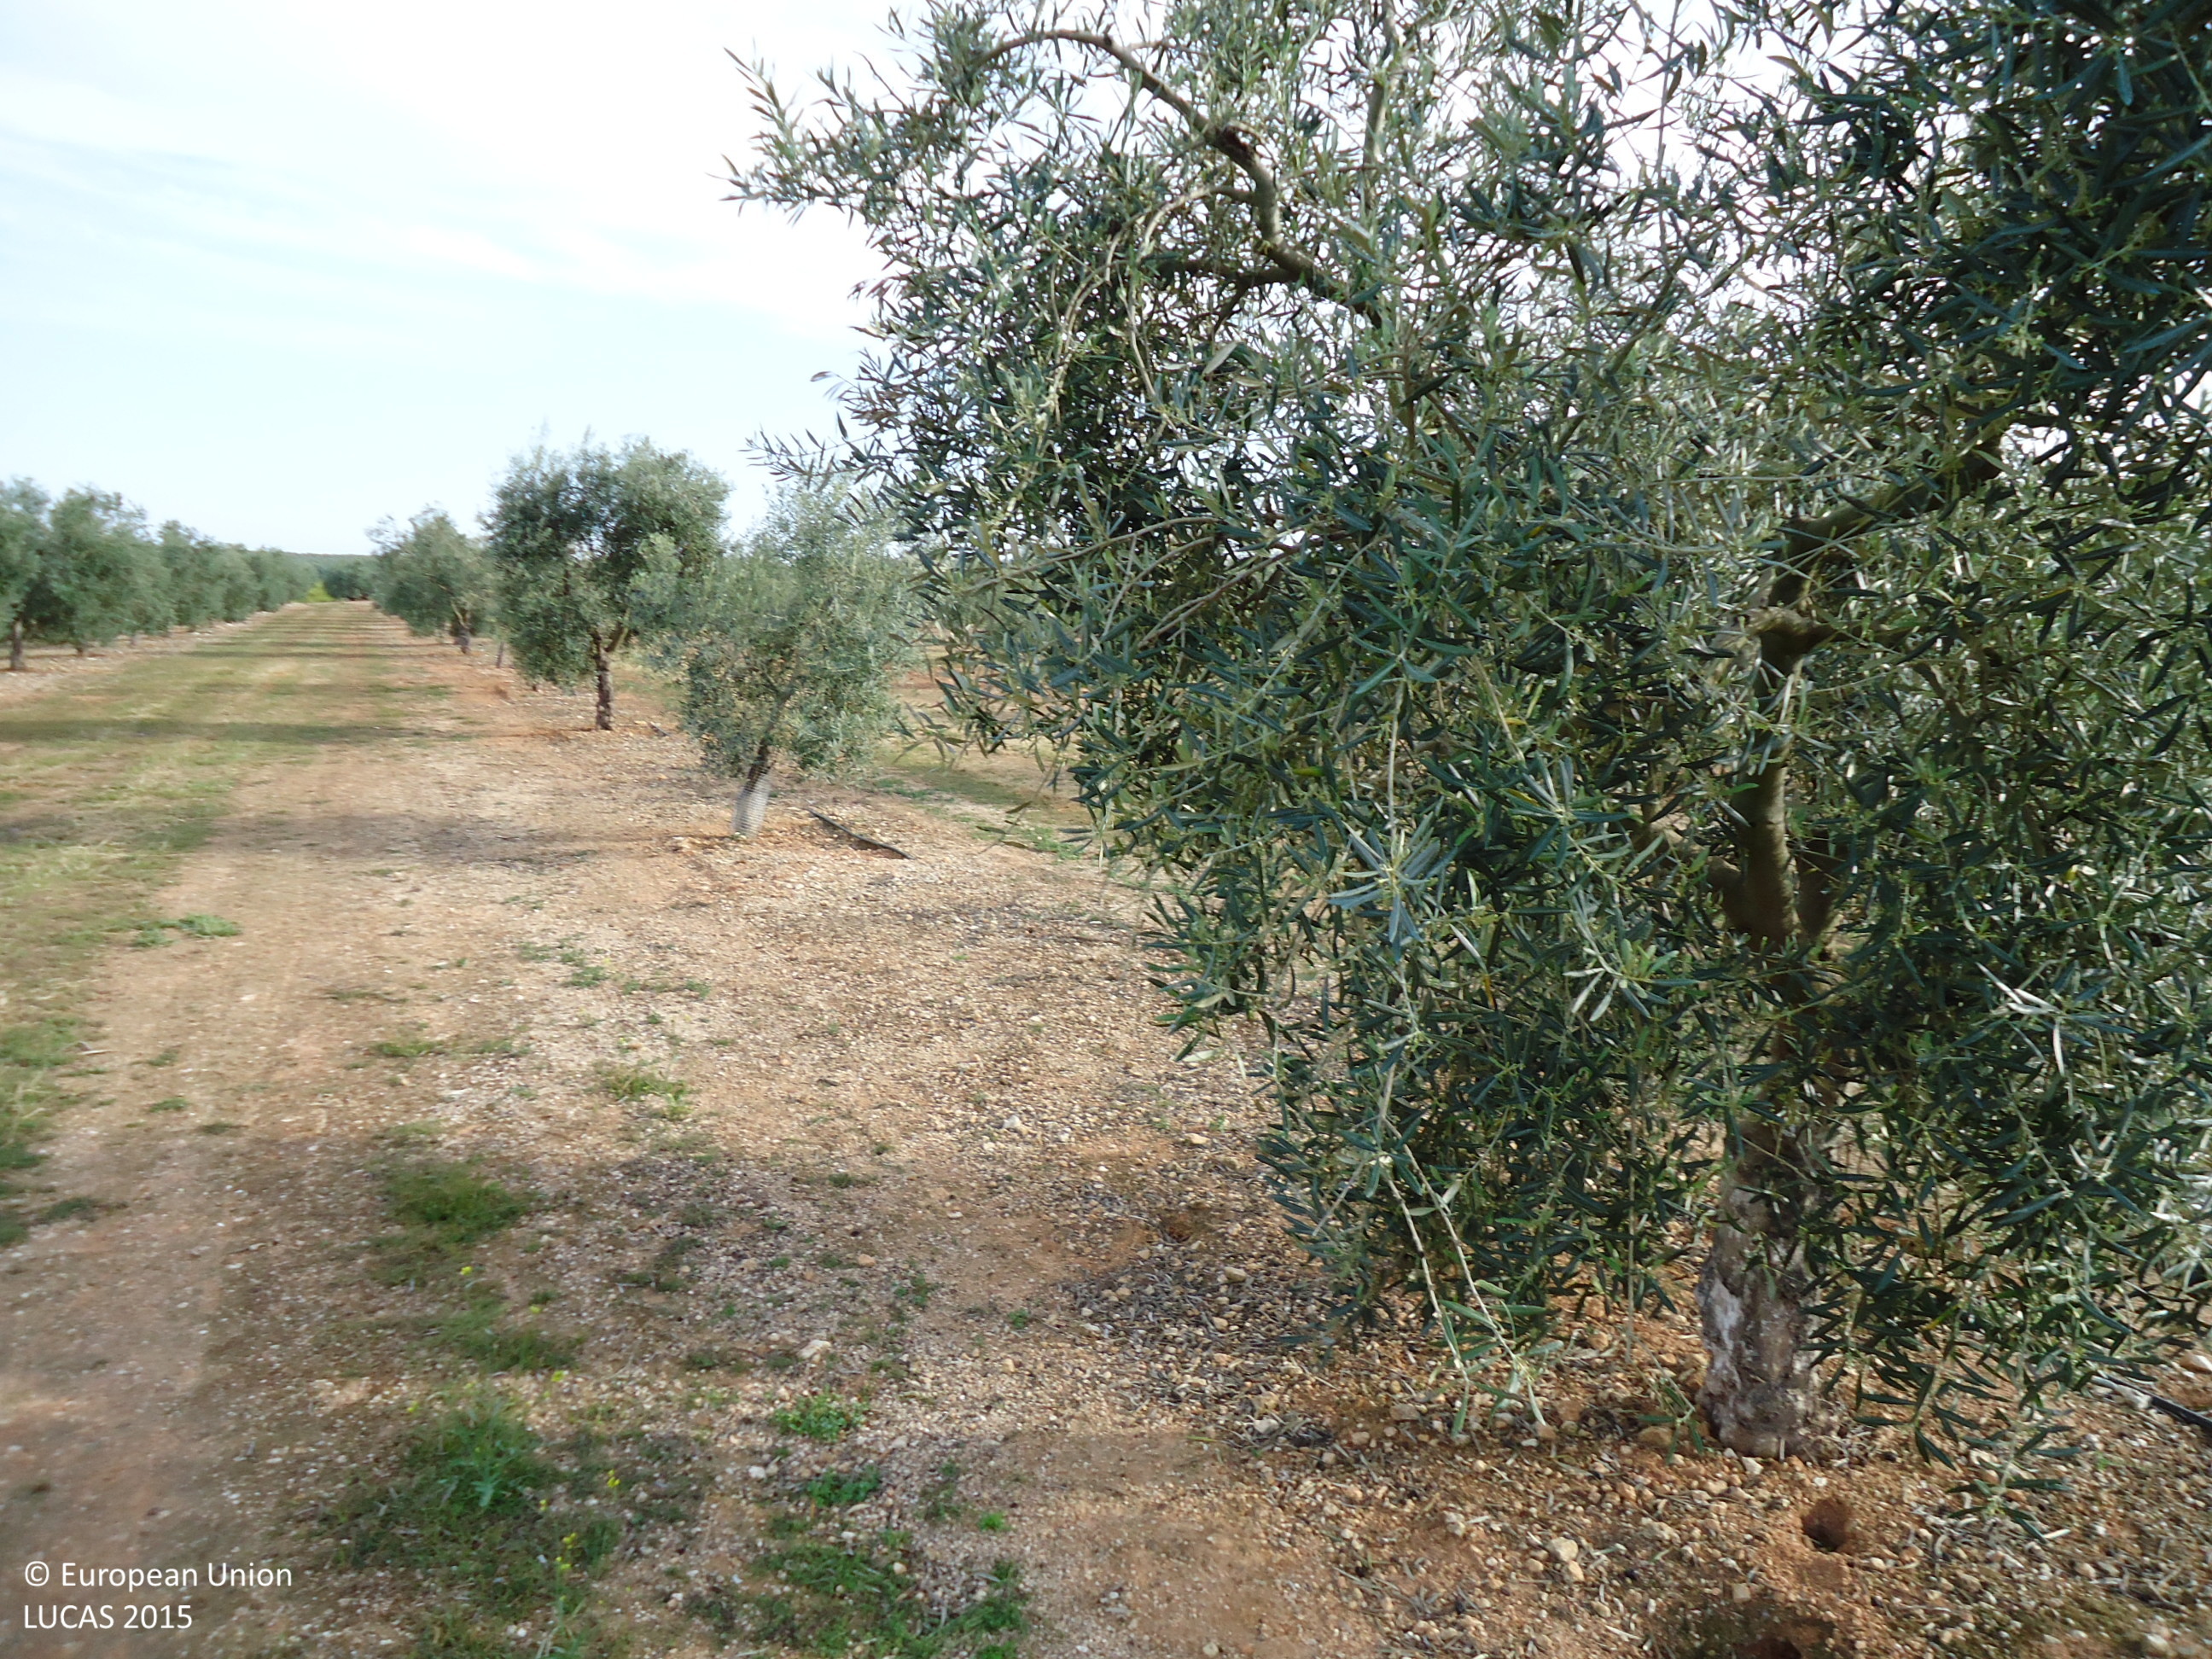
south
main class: Cropland
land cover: Olive groves
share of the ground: 10 - 25 %
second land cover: Spontaneously vegetated surfaces
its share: 10 - 25 %
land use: Agriculture (excluding fallow land and kitchen gardens)
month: April
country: ES
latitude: 37.1516
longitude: -4.8082
